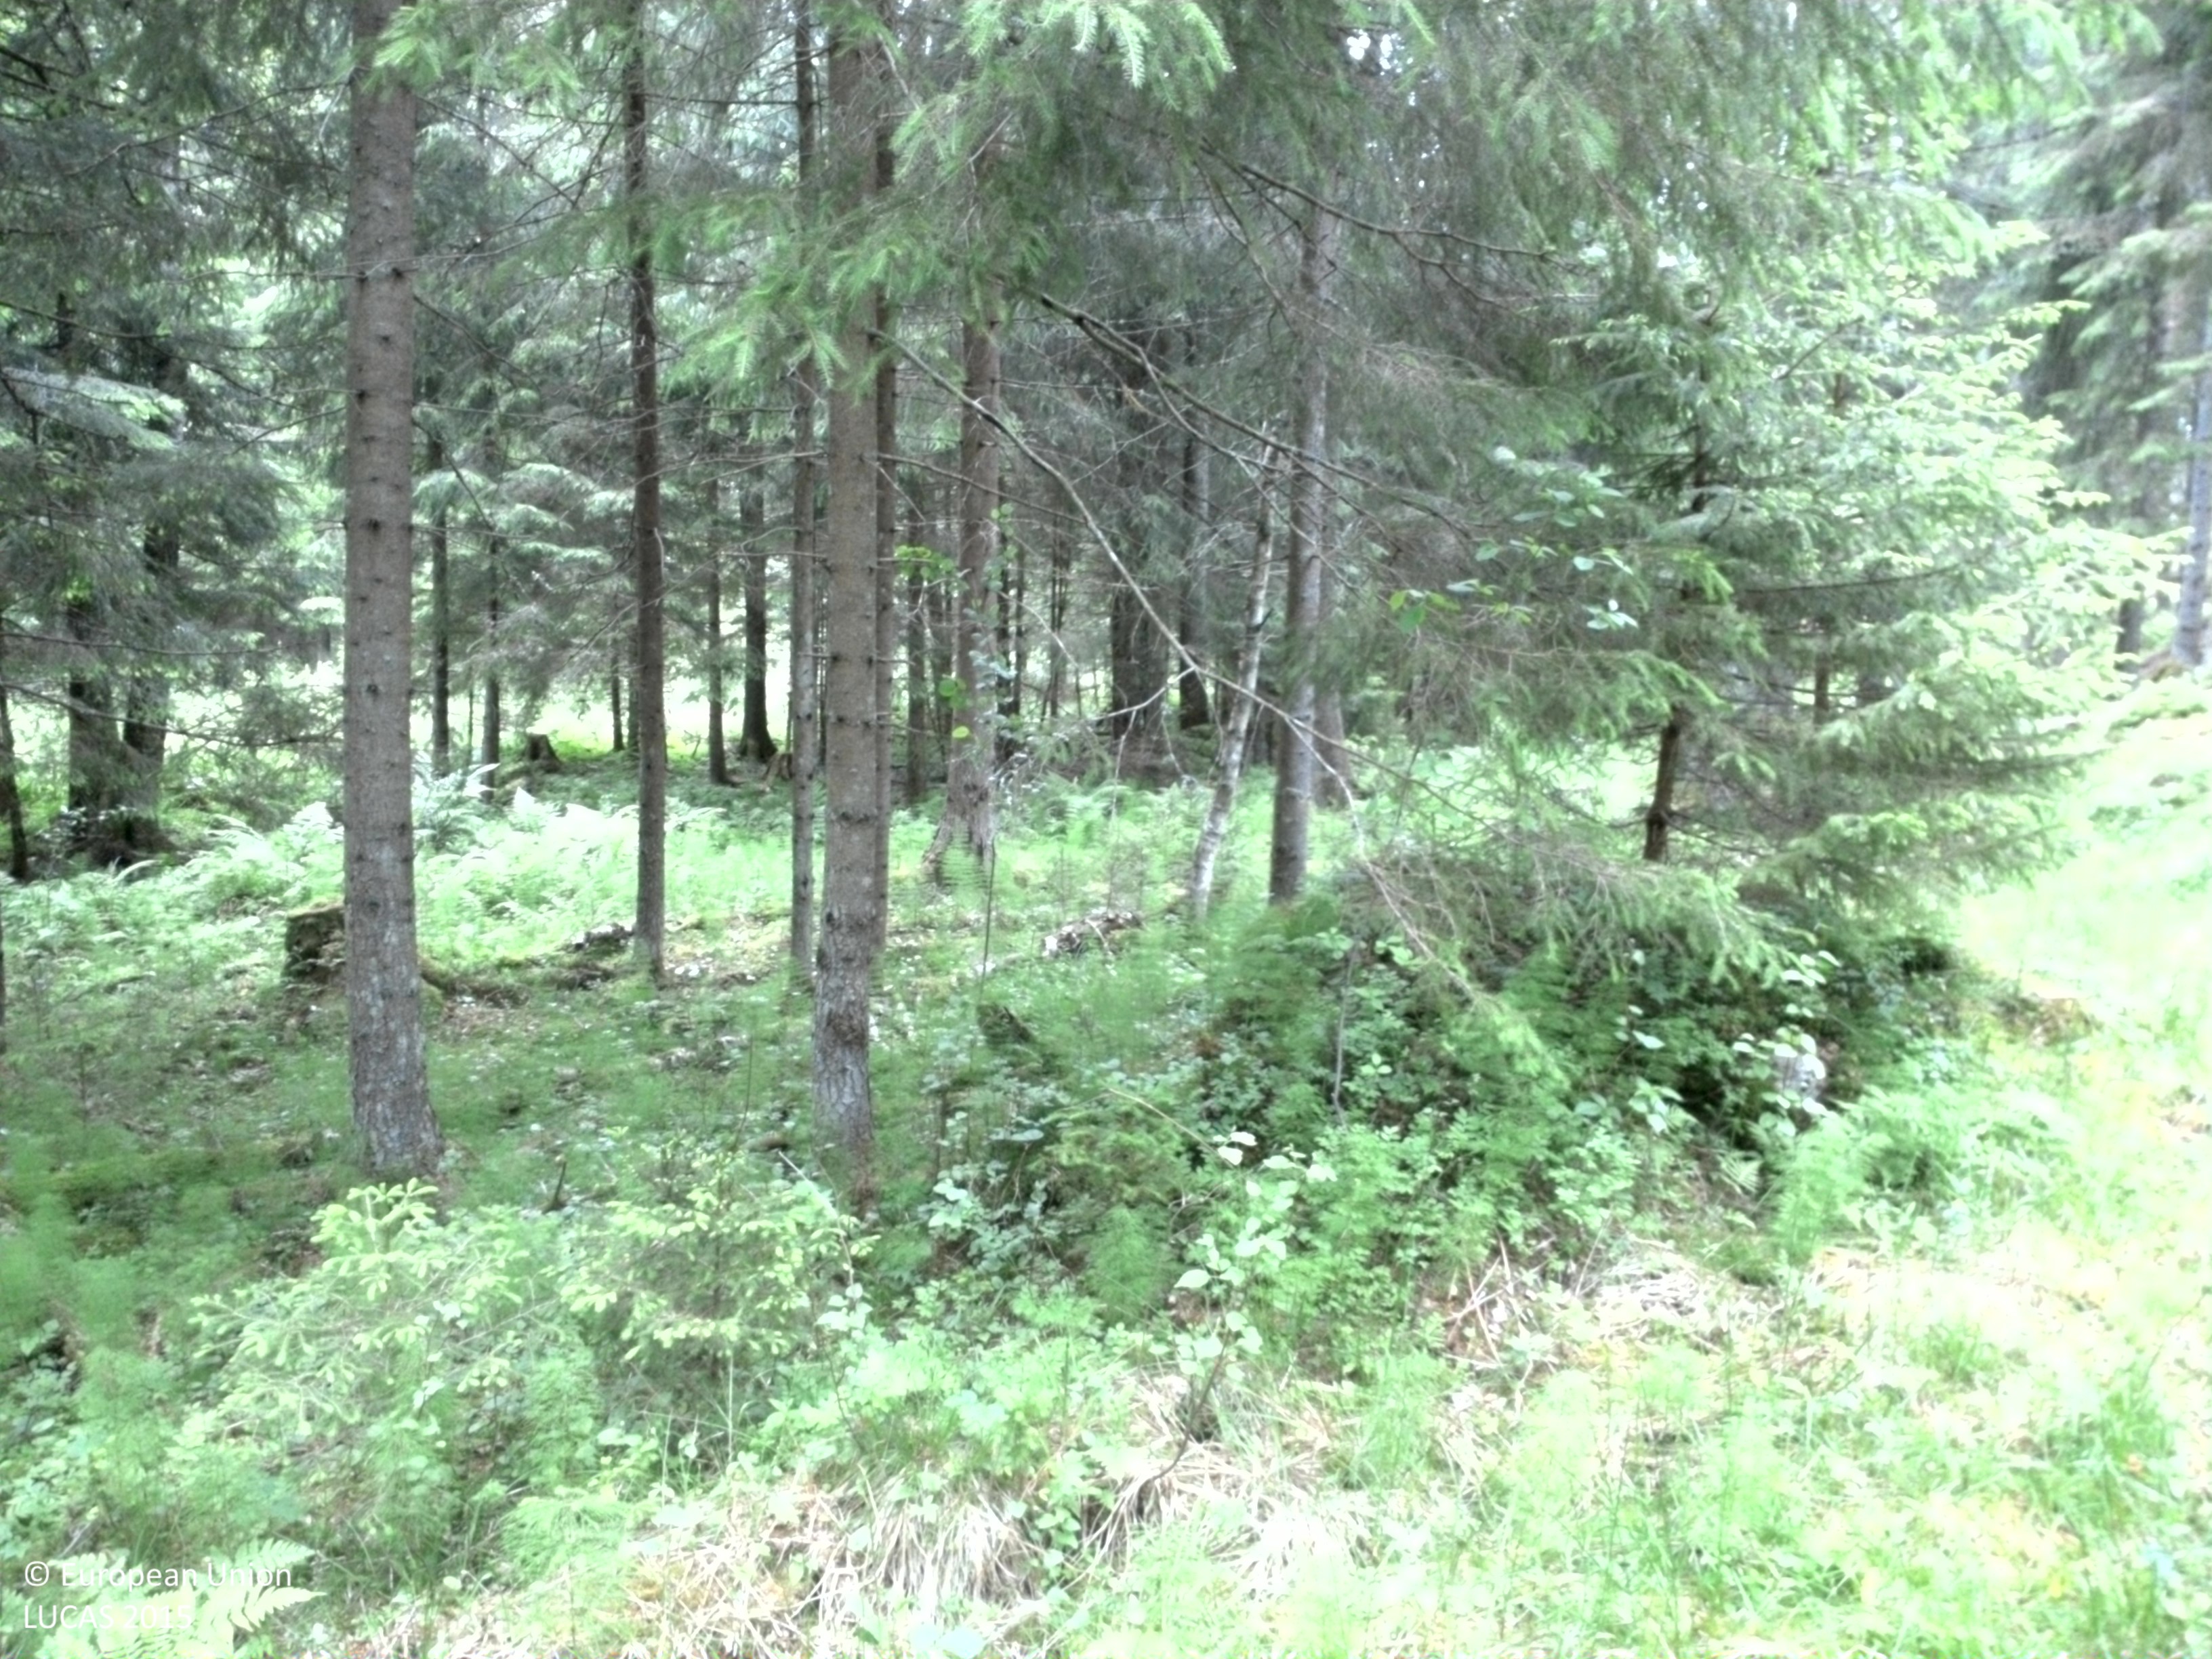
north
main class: Woodland
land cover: Spruce dominated coniferous woodland
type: boreal forest
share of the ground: 25 - 50 %
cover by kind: herbaceous plants 55 %, coniferous forest trees 30 %, lichens and mosses 10 %, broadleaved forest trees 5 %
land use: Forestry
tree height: > 5 m
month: June
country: SE
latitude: 58.6980
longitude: 15.6021
